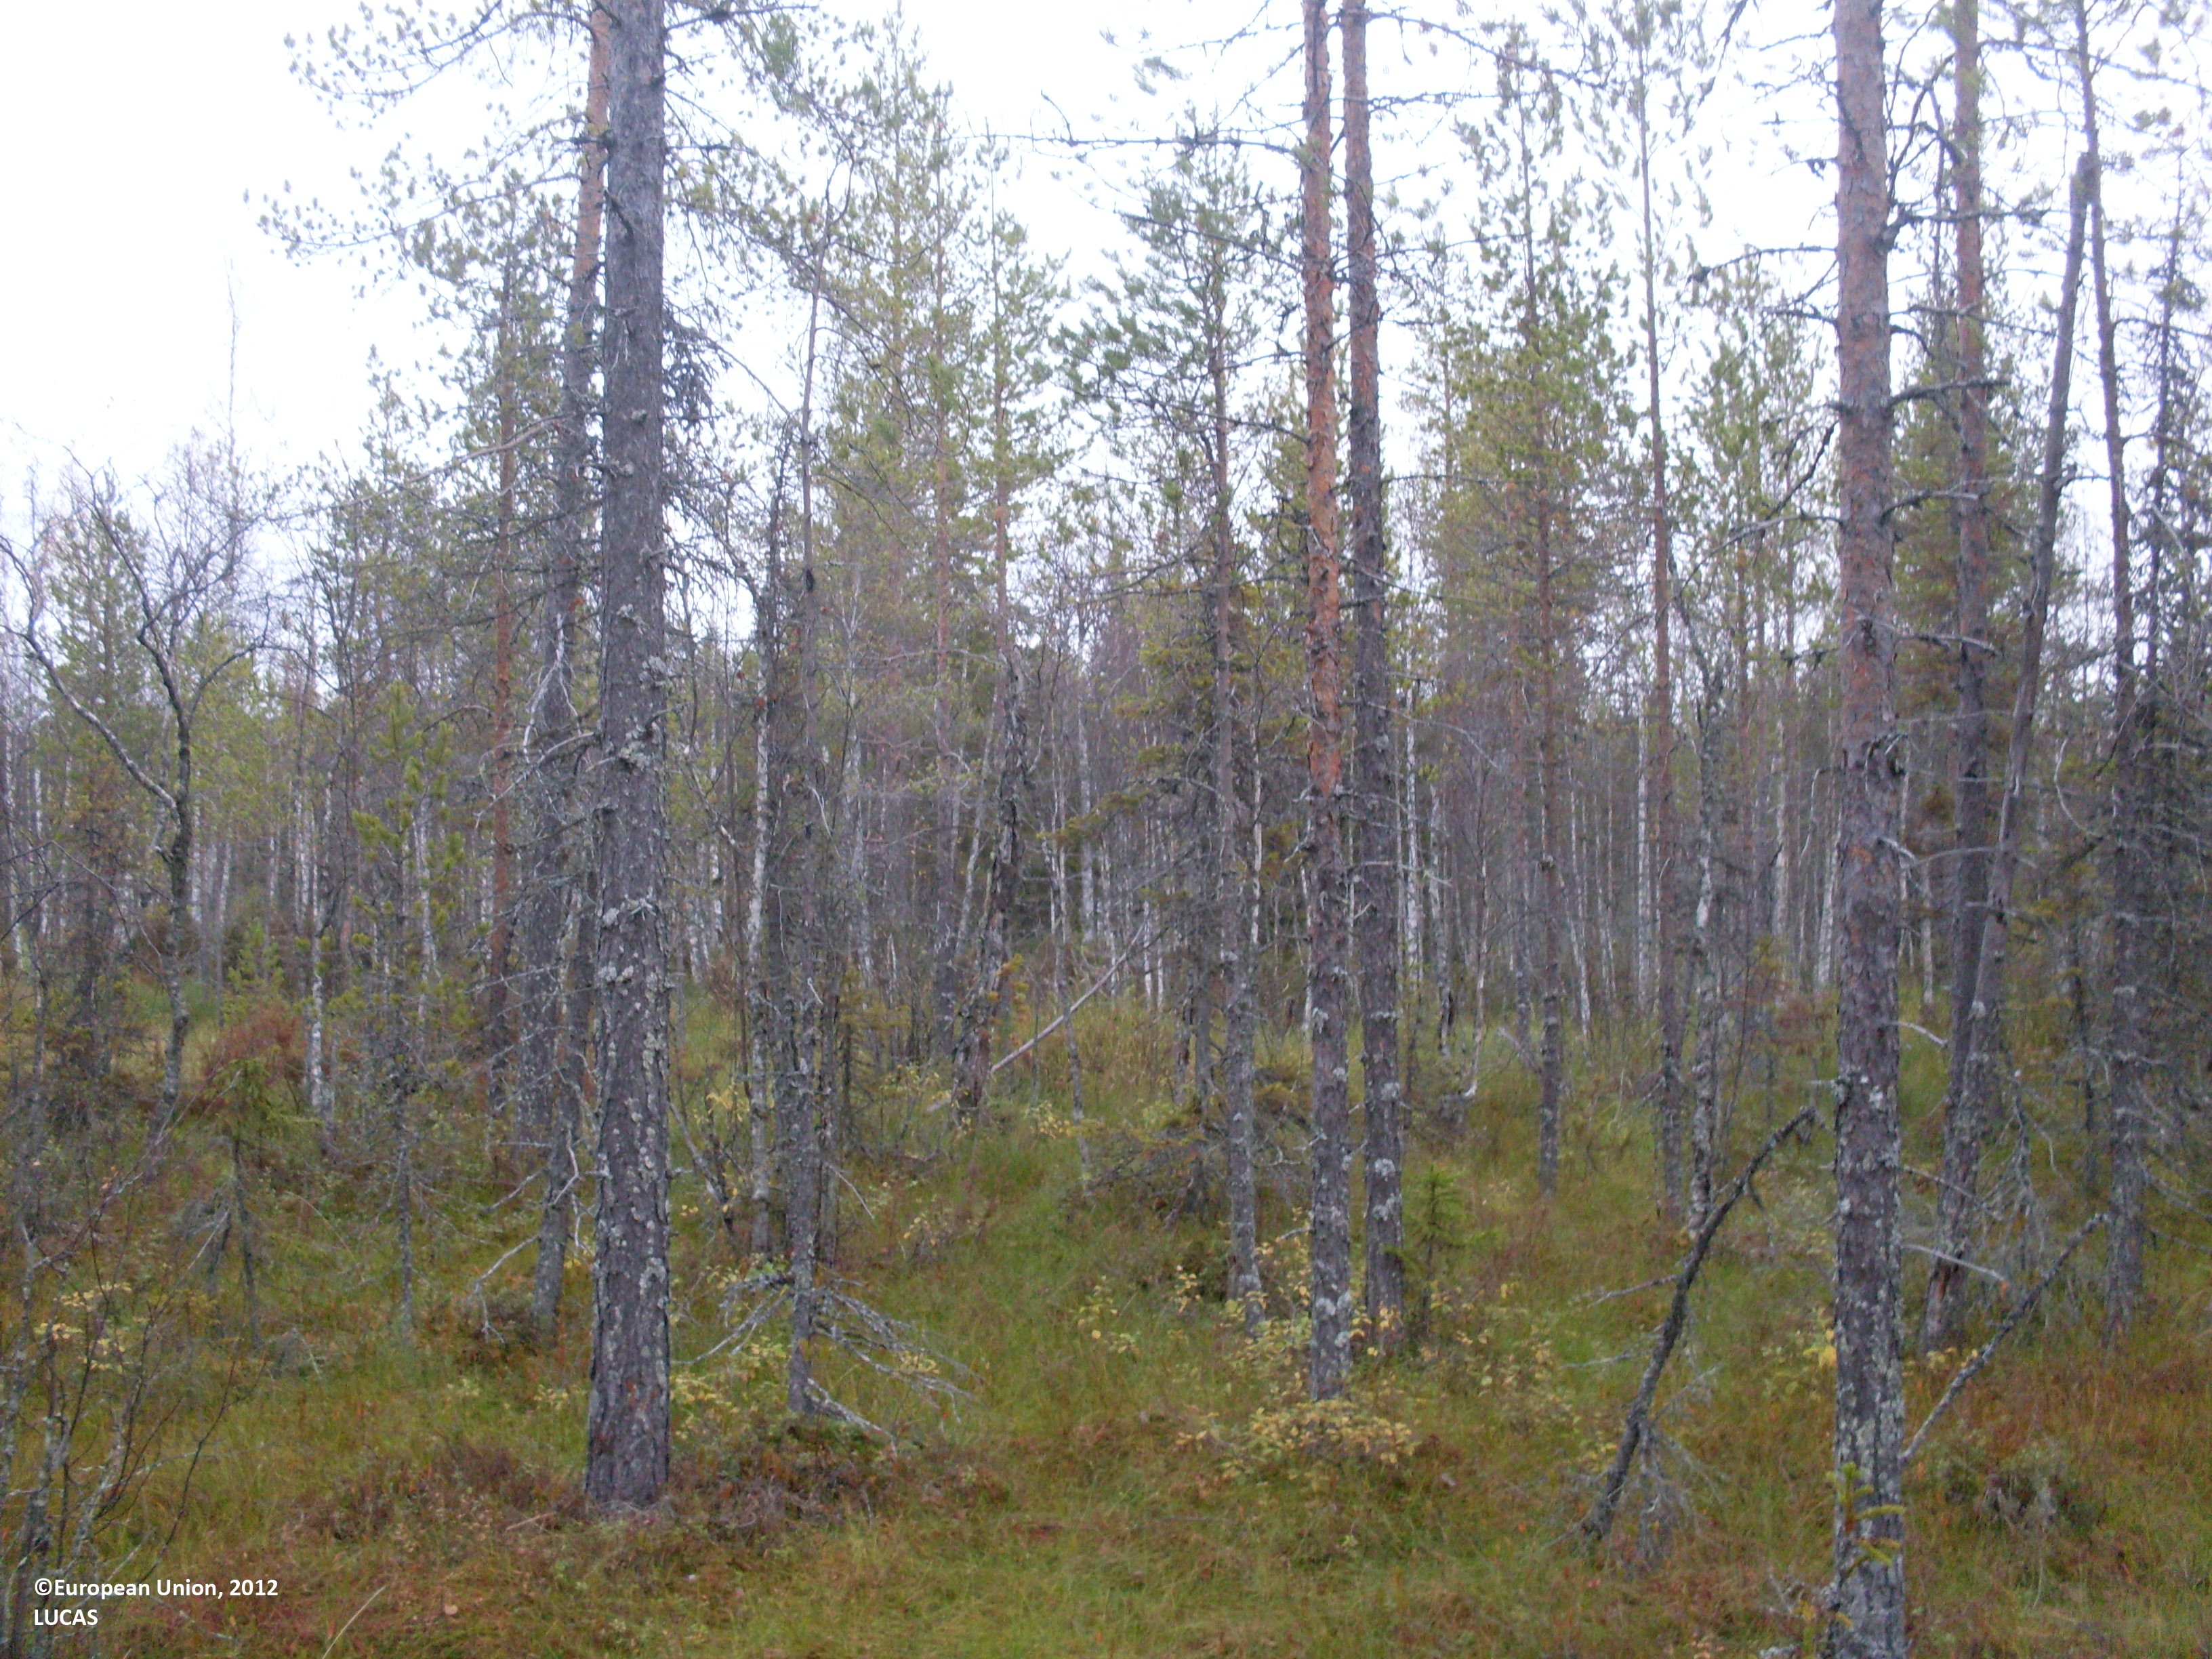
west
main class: Woodland
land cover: Pine dominated coniferous woodland
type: boreal forest
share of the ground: 25 - 50 %
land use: Forestry
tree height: > 5 m
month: September
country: FI
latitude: 64.5513
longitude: 29.6800
